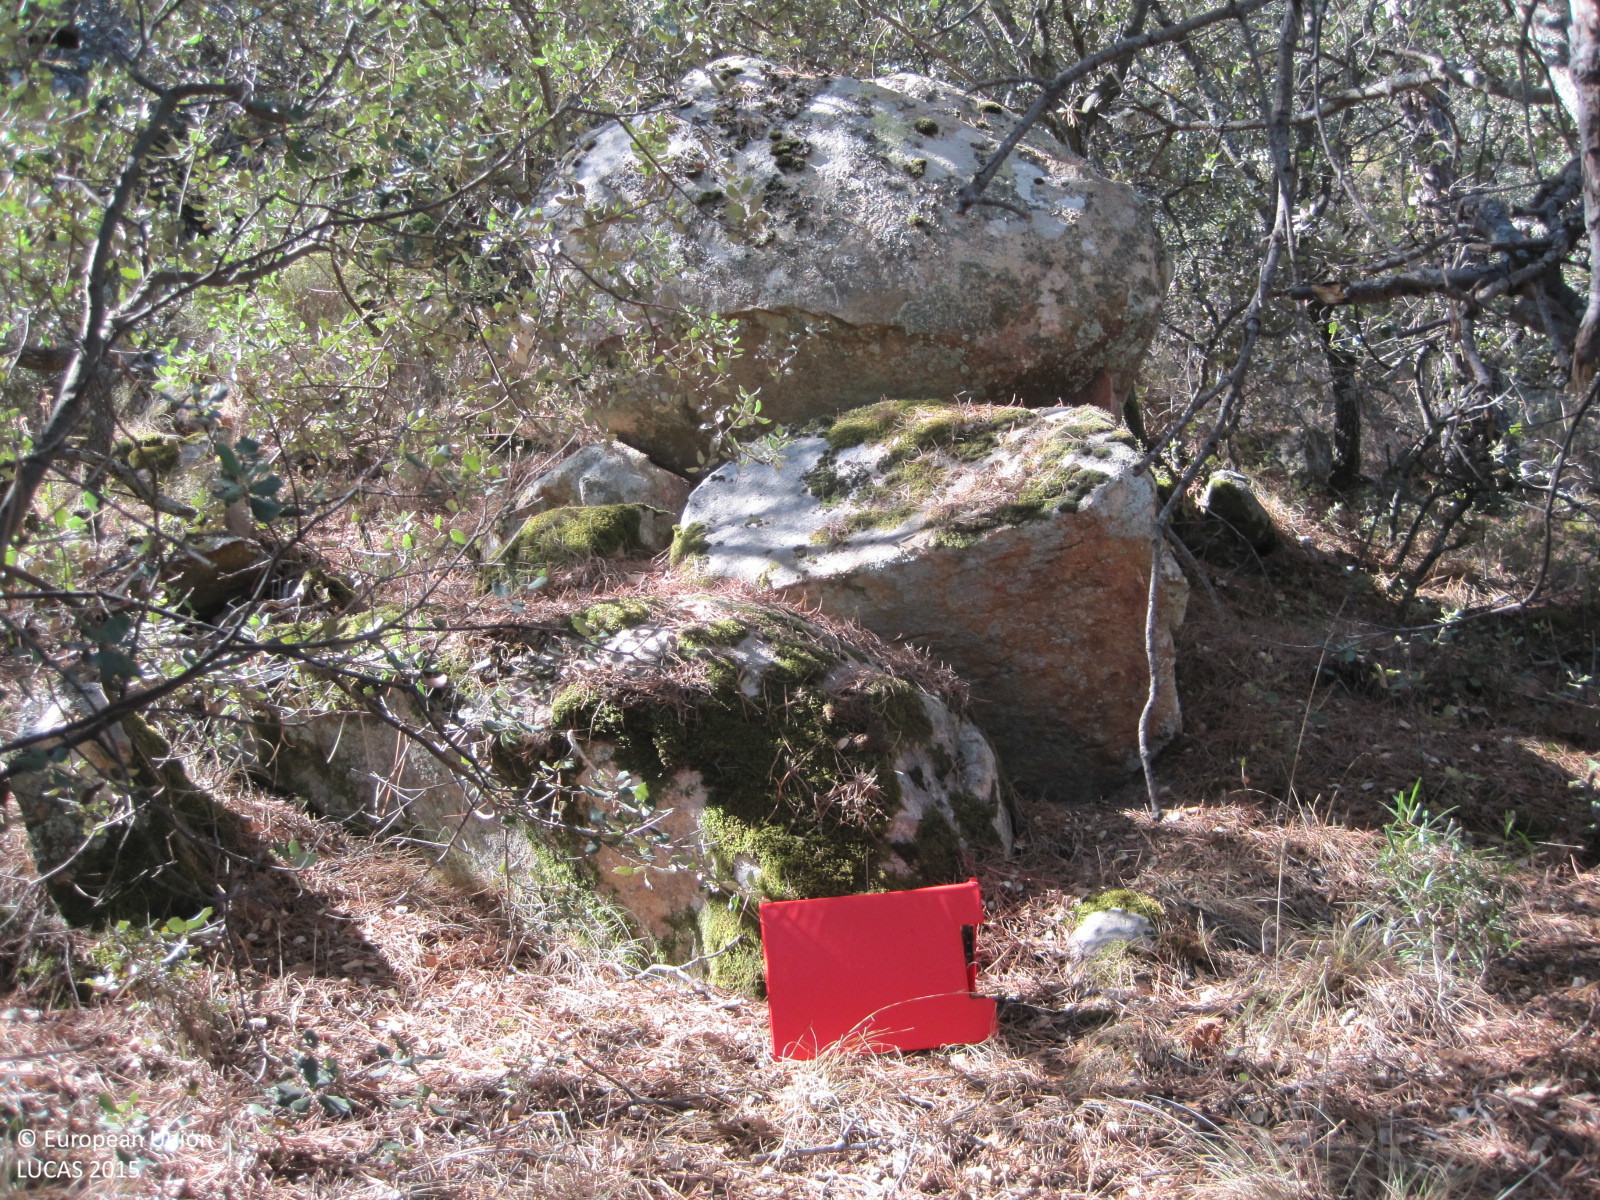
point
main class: Woodland
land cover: Pine dominated mixed woodland
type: coniferous forest of the mediterranean region
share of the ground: > 75 %
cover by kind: coniferous forest trees 75 %, broadleaved forest trees 25 %
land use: Forestry
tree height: > 5 m
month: July
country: ES
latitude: 40.2835
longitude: -4.3834
